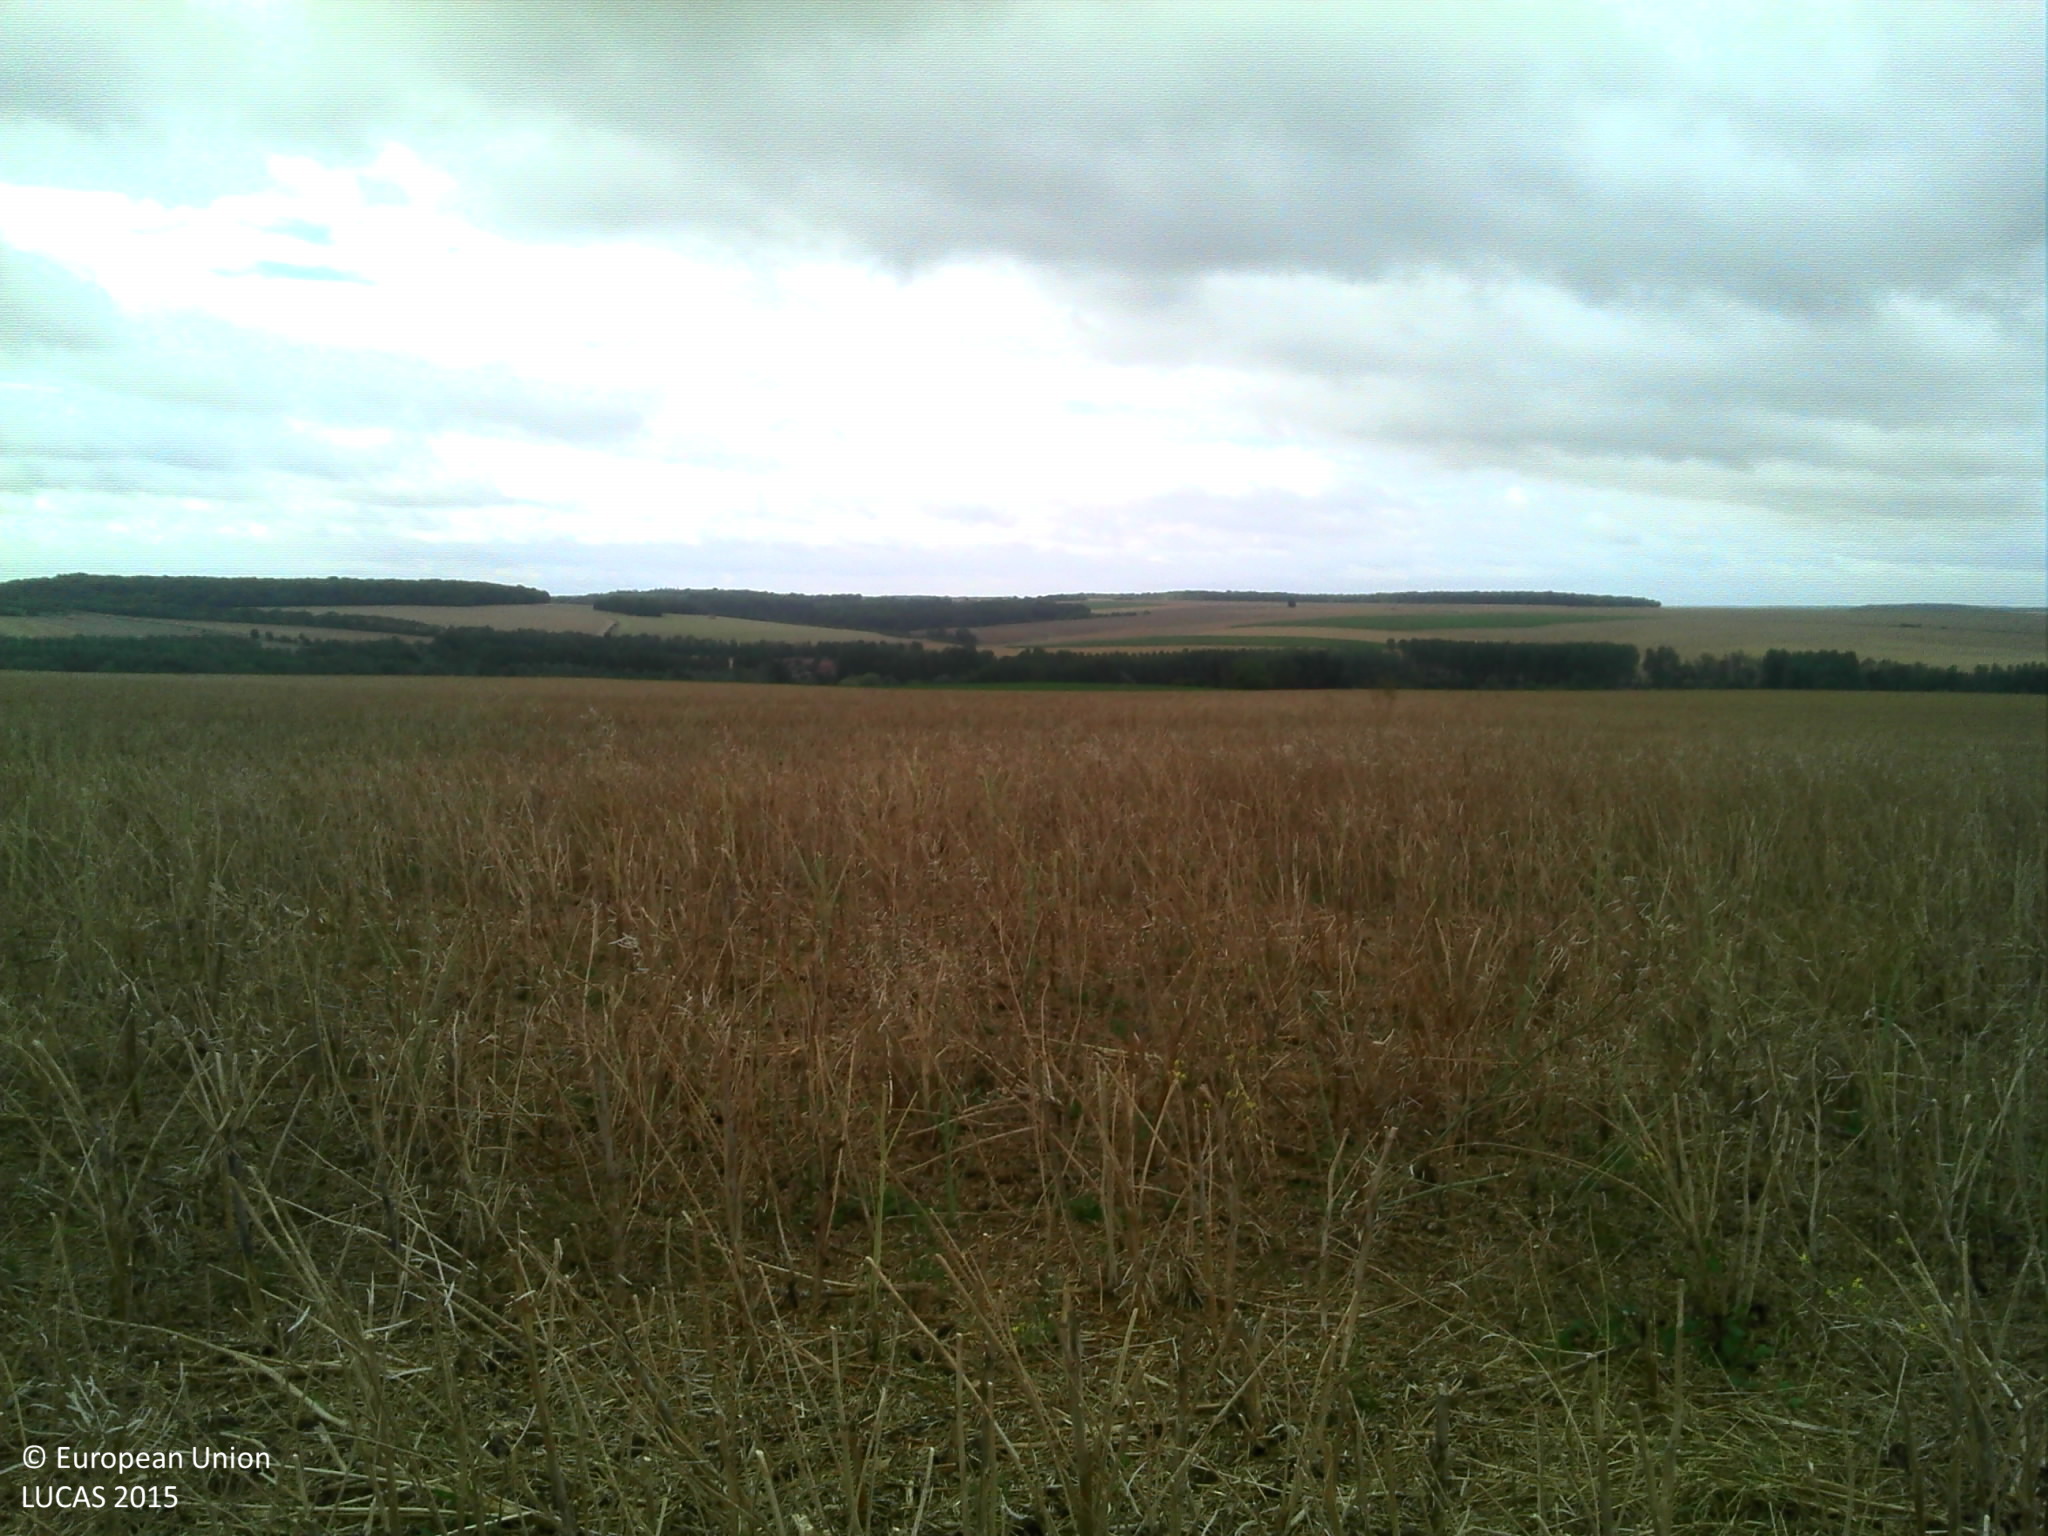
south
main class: Cropland
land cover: Rape and turnip rape
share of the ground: 25 - 50 %
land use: Agriculture (excluding fallow land and kitchen gardens)
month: July
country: FR
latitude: 49.8283
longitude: 2.4948
